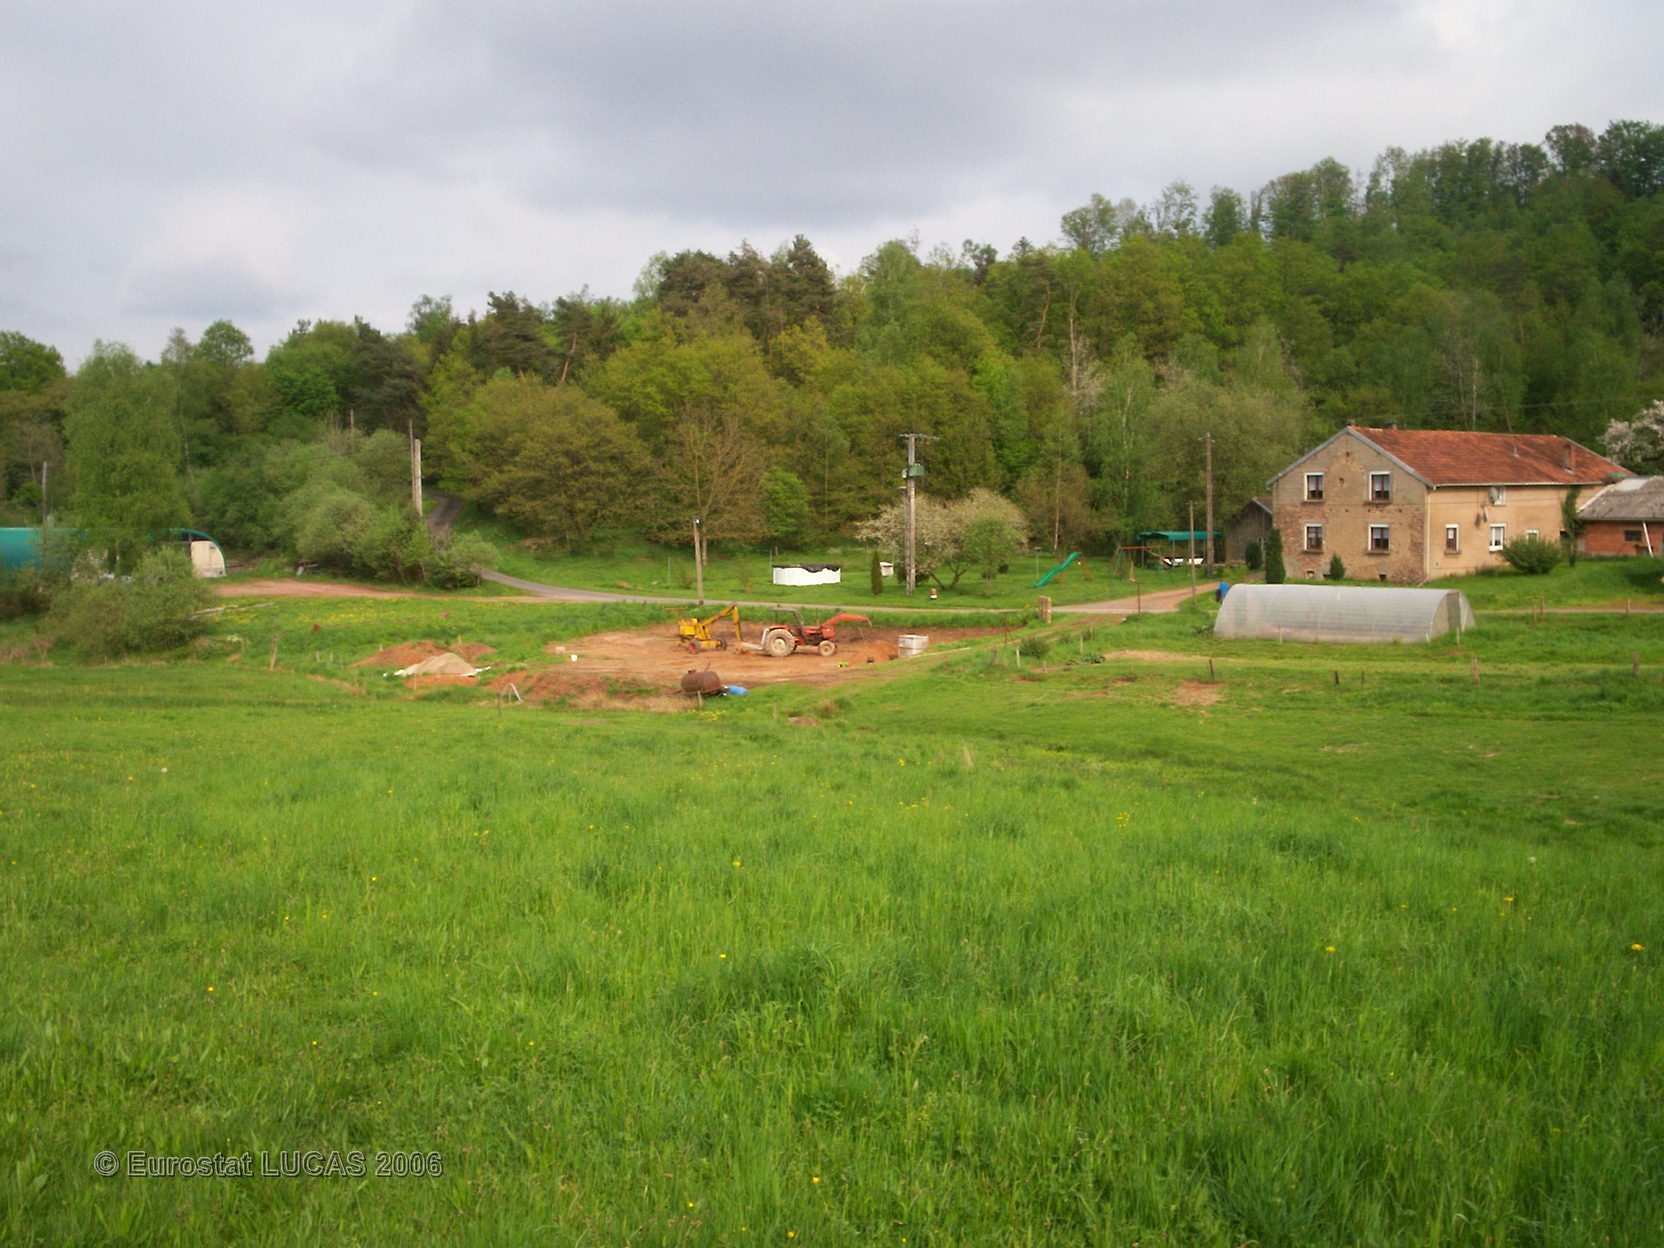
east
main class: Grassland
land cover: Grassland without tree/shrub cover
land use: Agriculture (excluding fallow land and kitchen gardens)
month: May
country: FR
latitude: 48.5970
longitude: 7.0040
